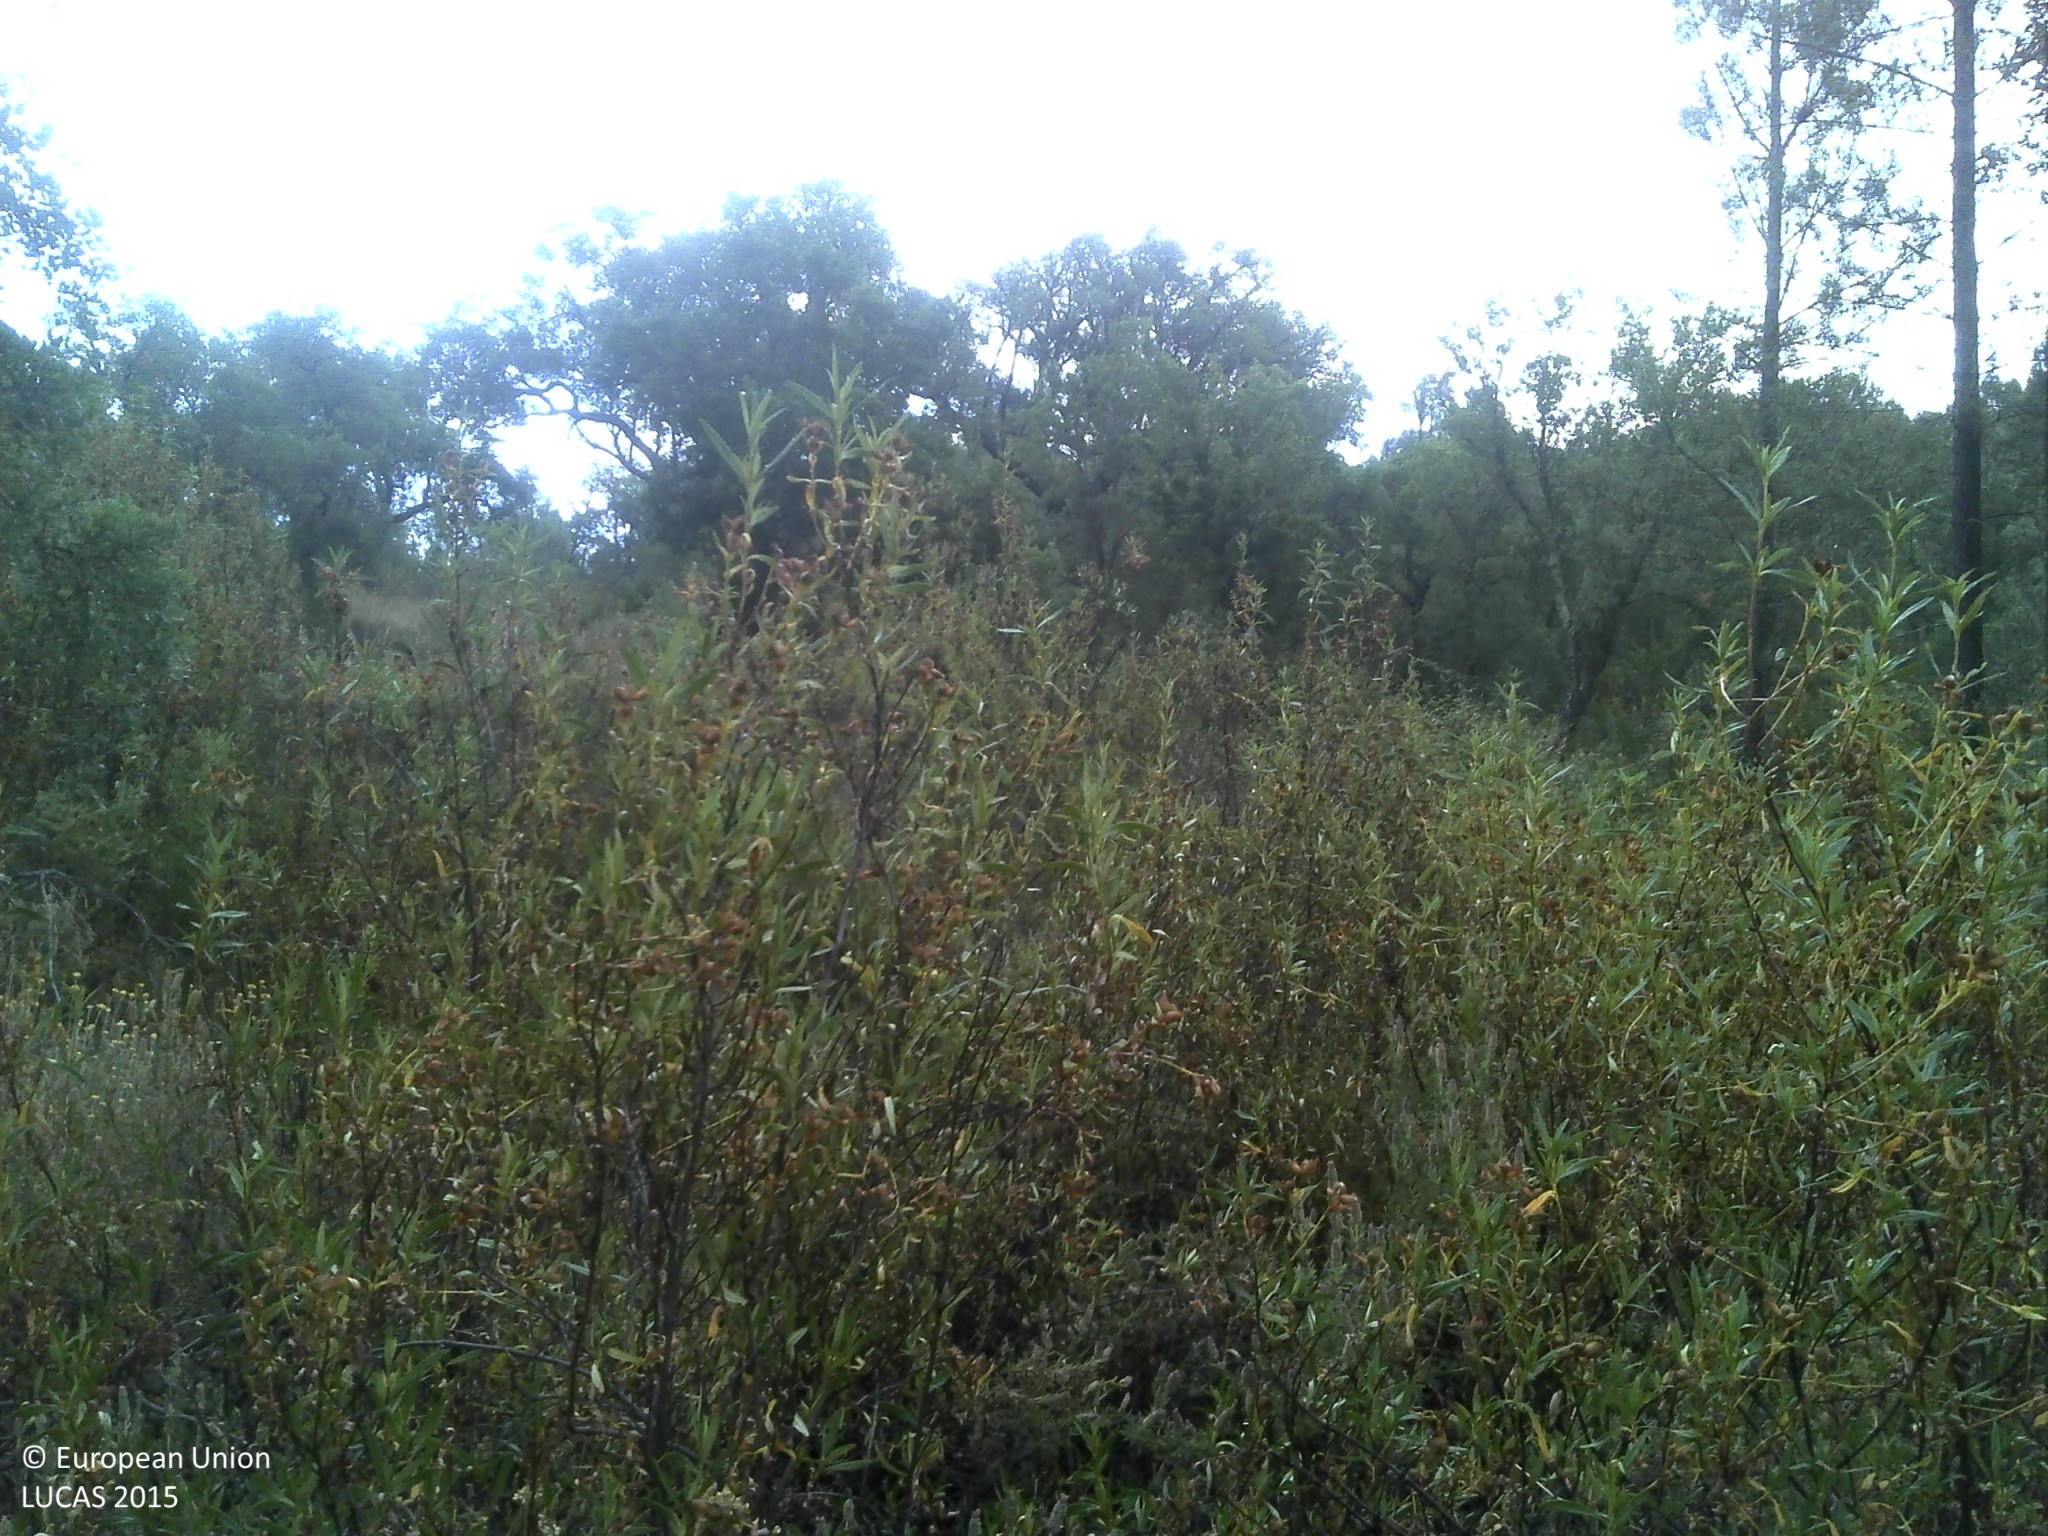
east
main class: Woodland
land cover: Broadleaved woodland
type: broadleaved evergreen forest
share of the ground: 10 - 25 %
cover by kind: shrubs 50 %, broadleaved forest trees 25 %, unconsolidated bare surface 15 %, herbaceous plants 10 %
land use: Forestry
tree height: > 5 m
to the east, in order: Broadleaved woodland; Tracks; Pine dominated coniferous woodland; Shrubland with sparse tree cover; Broadleaved woodland; Olive groves; Broadleaved woodland
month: June
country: PT
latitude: 39.3702
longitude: -8.0615
